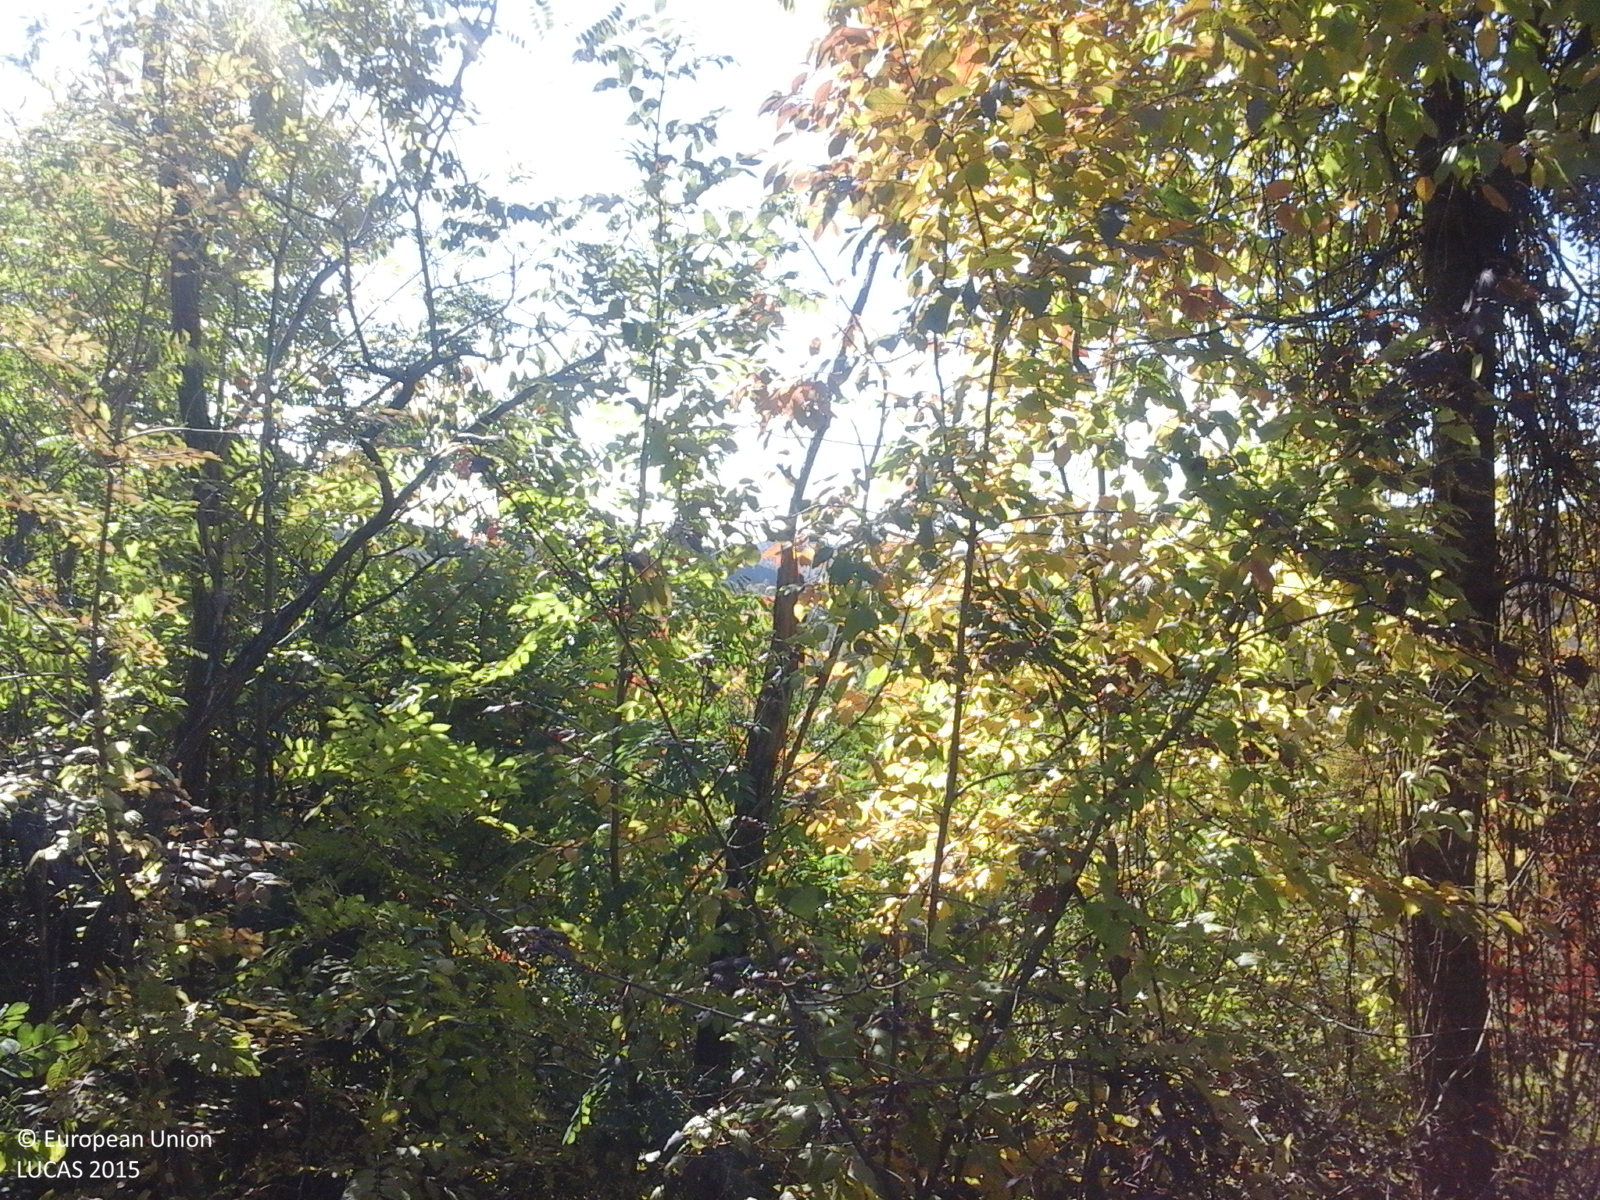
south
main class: Grassland
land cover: Grassland with sparse tree/shrub cover
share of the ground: > 75 %
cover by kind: herbaceous plants 95 %, broadleaved forest trees 5 %
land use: Agriculture (excluding fallow land and kitchen gardens)
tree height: > 5 m
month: October
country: RO
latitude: 45.2189
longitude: 25.7028
